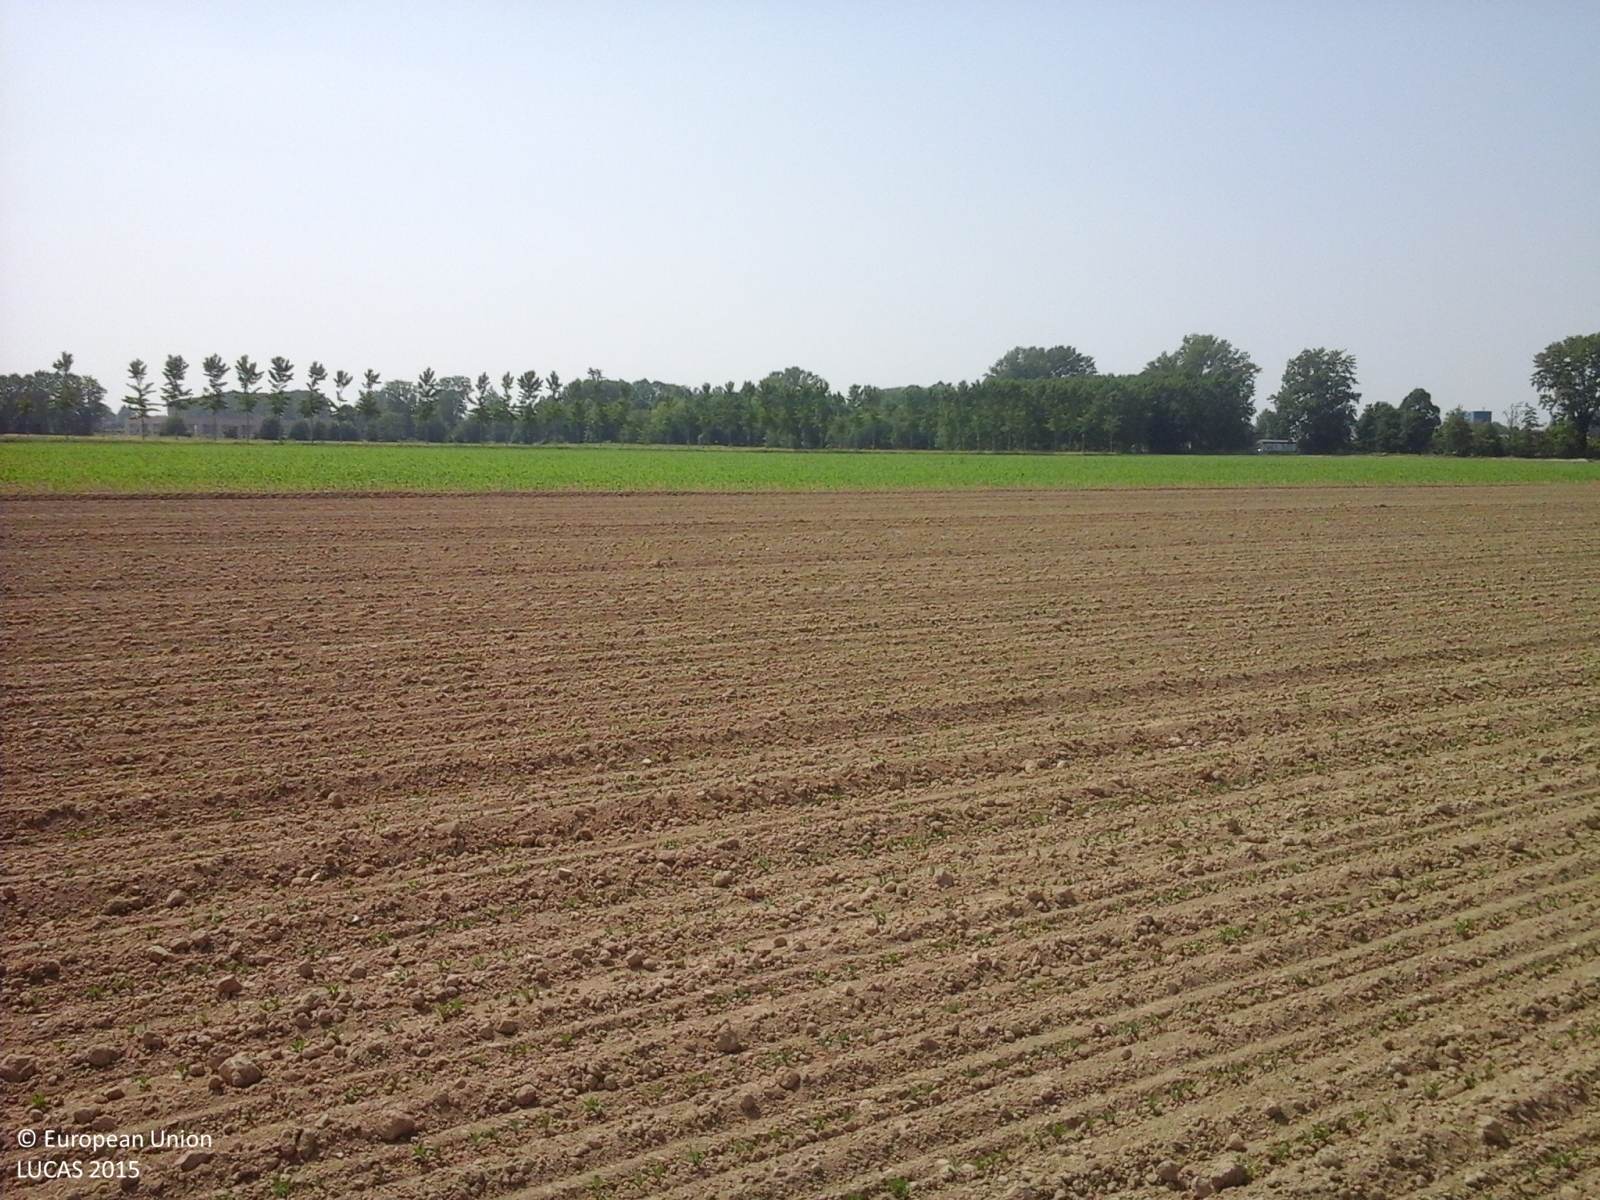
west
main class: Cropland
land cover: Soya
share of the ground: < 10 %
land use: Agriculture (excluding fallow land and kitchen gardens)
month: May
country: IT
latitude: 45.2142
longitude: 9.3772
